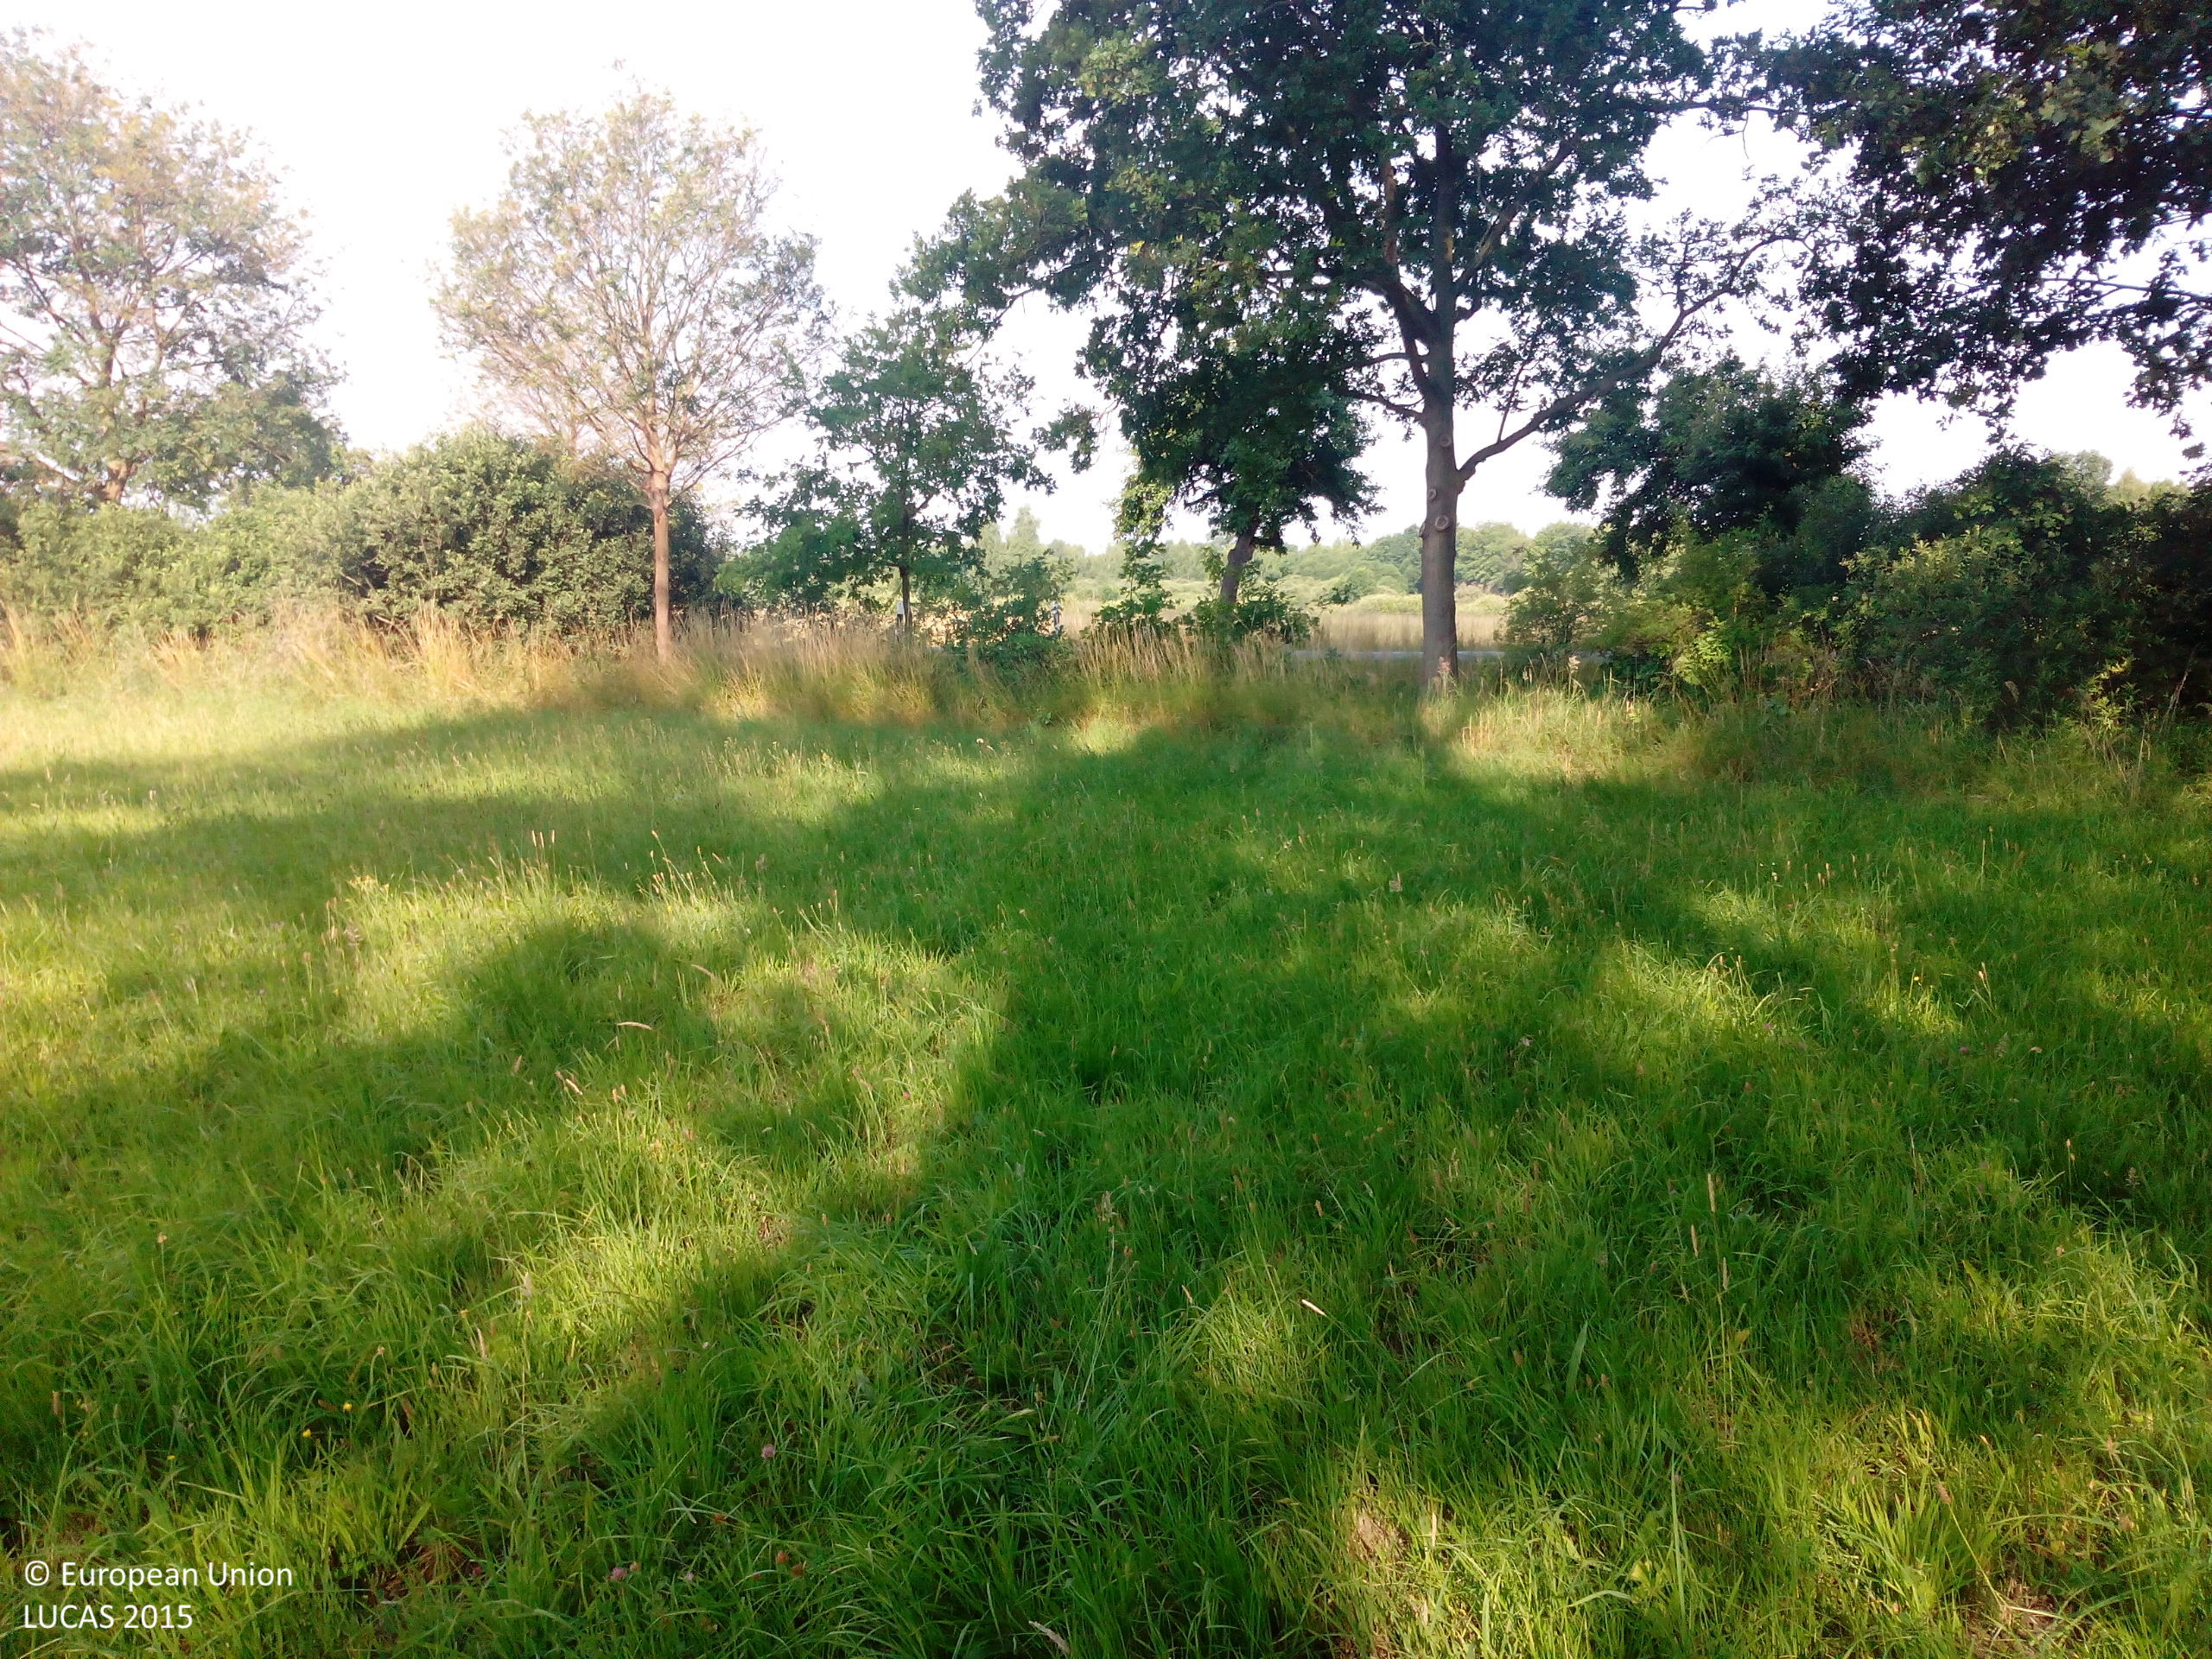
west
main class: Grassland
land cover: Grassland without tree/shrub cover
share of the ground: > 75 %
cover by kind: herbaceous plants 100 %
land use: Agriculture (excluding fallow land and kitchen gardens)
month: July
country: DE
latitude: 52.4979
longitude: 11.1338
